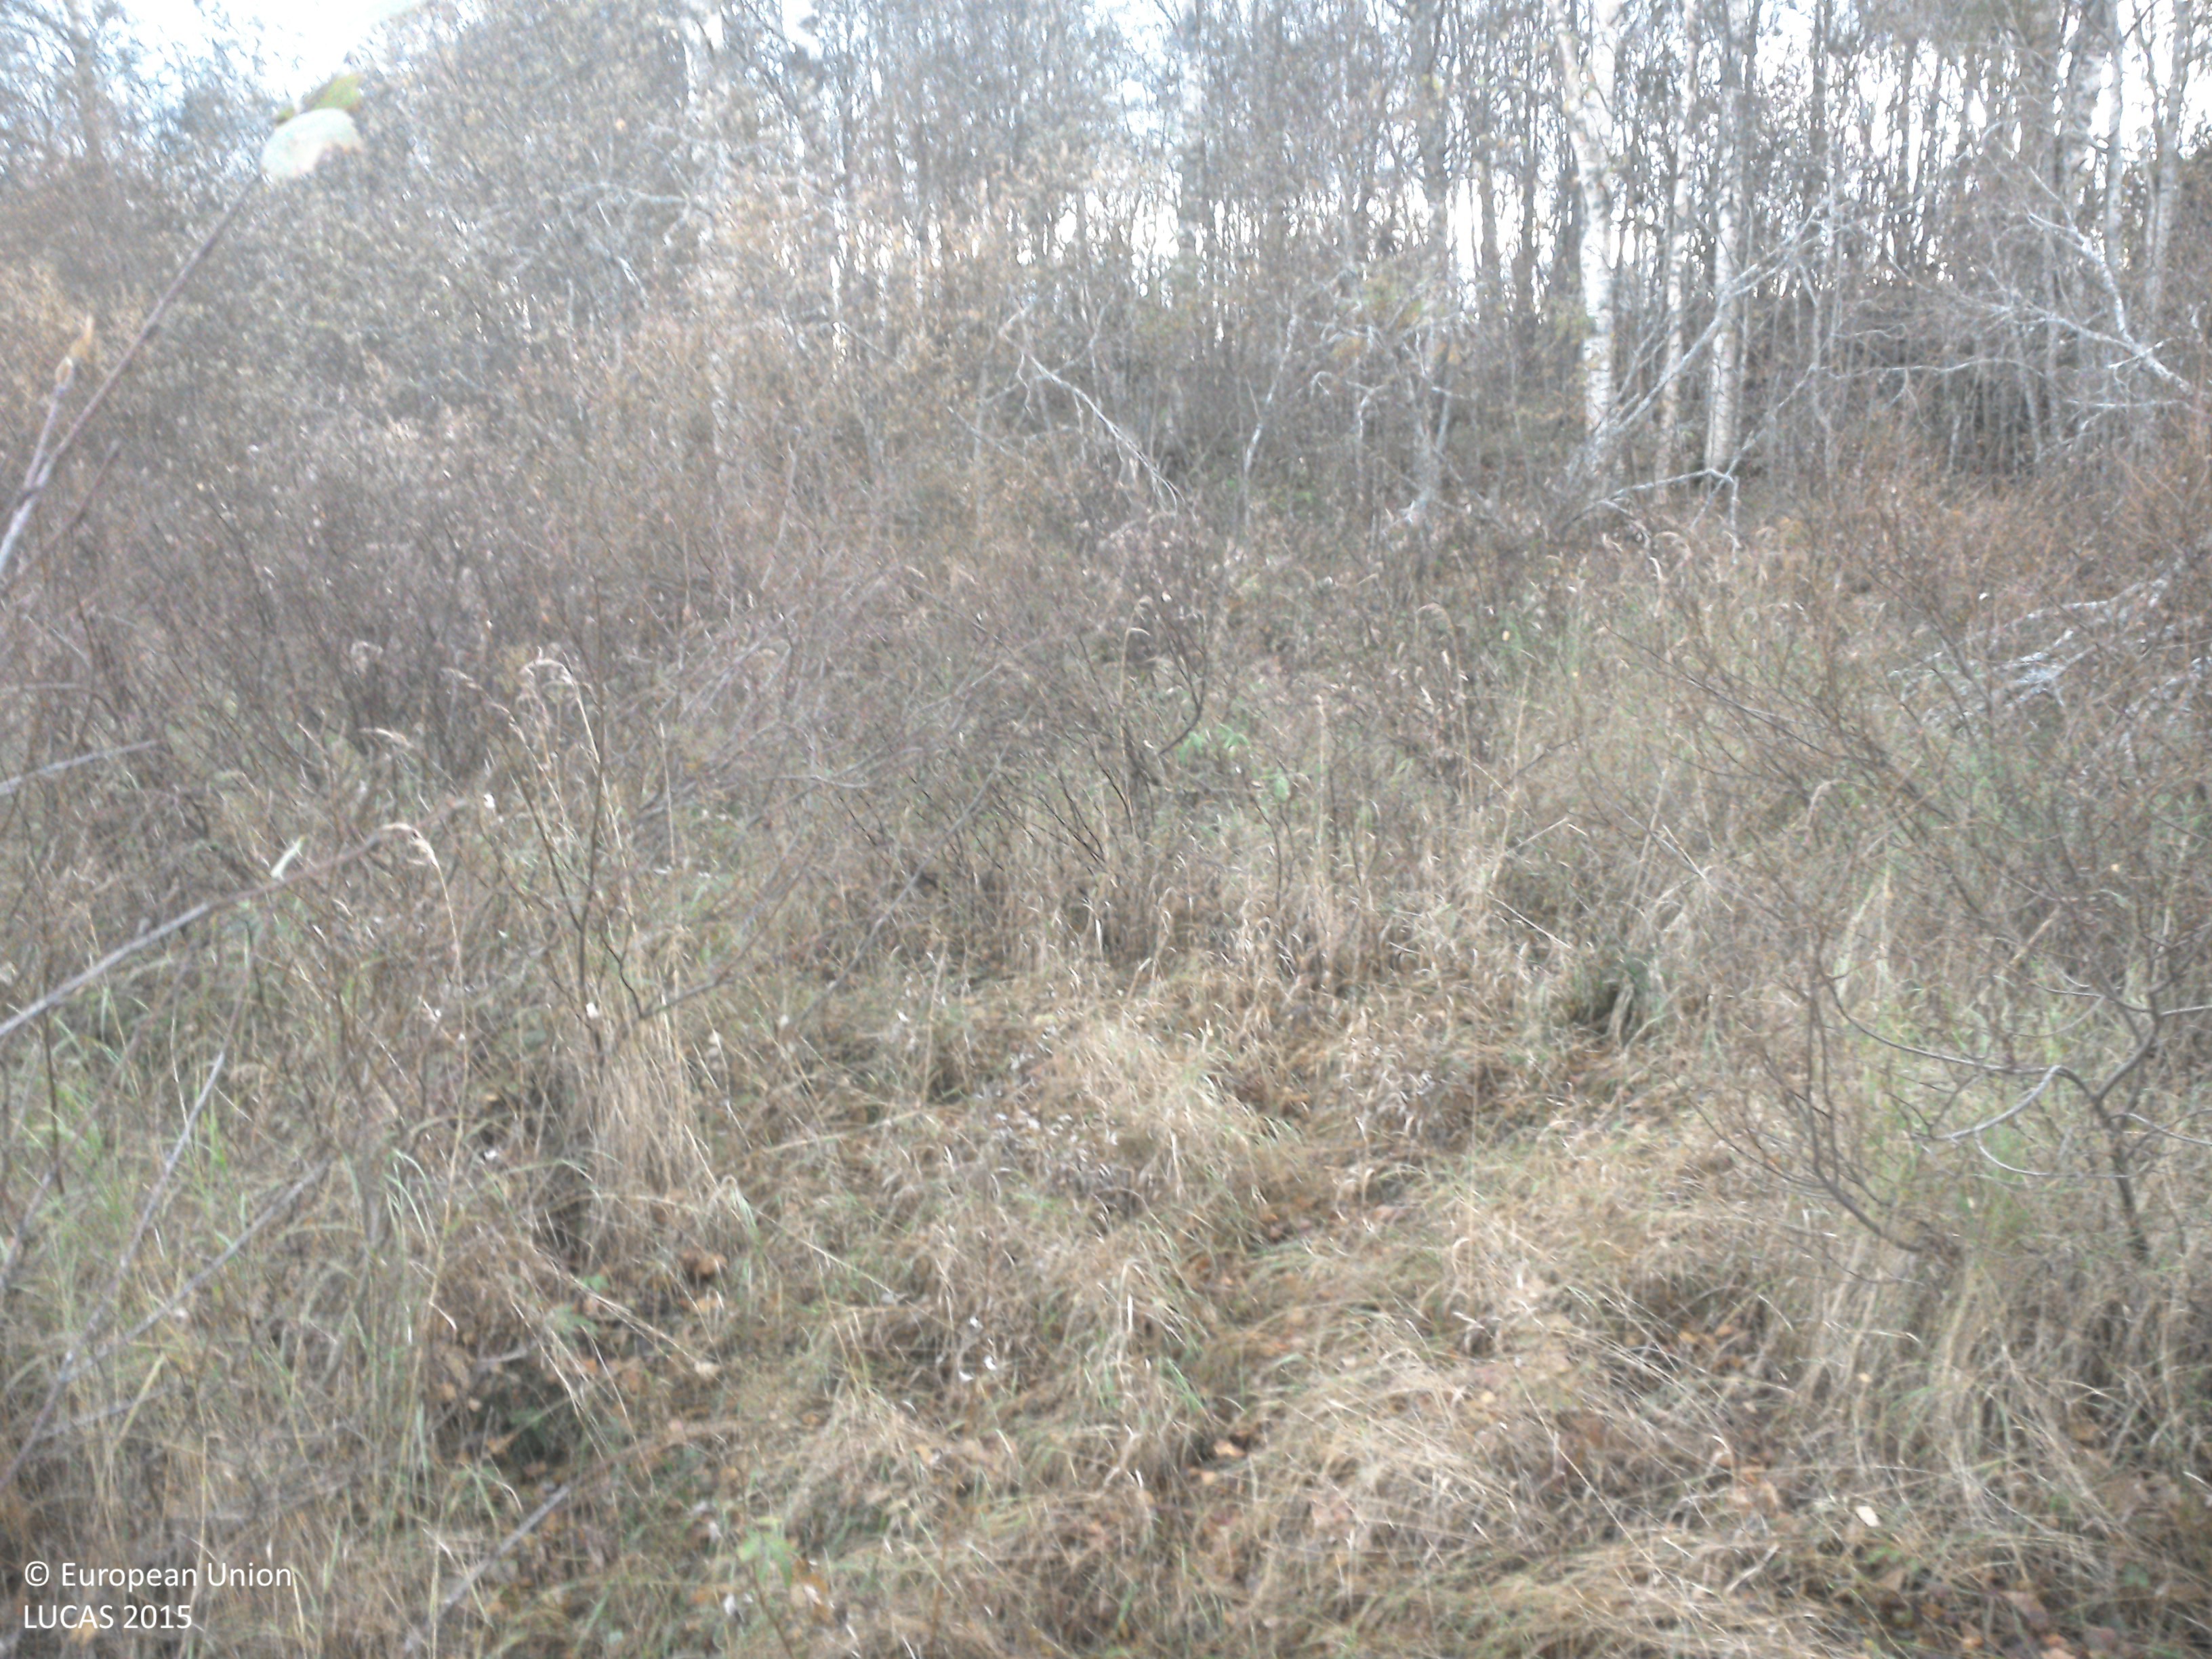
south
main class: Woodland
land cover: Broadleaved woodland
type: boreal forest
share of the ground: 25 - 50 %
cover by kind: herbaceous plants 60 %, broadleaved forest trees 40 %
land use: Semi-natural and natural areas not in use
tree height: > 5 m
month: October
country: SE
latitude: 63.8880
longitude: 19.8965
